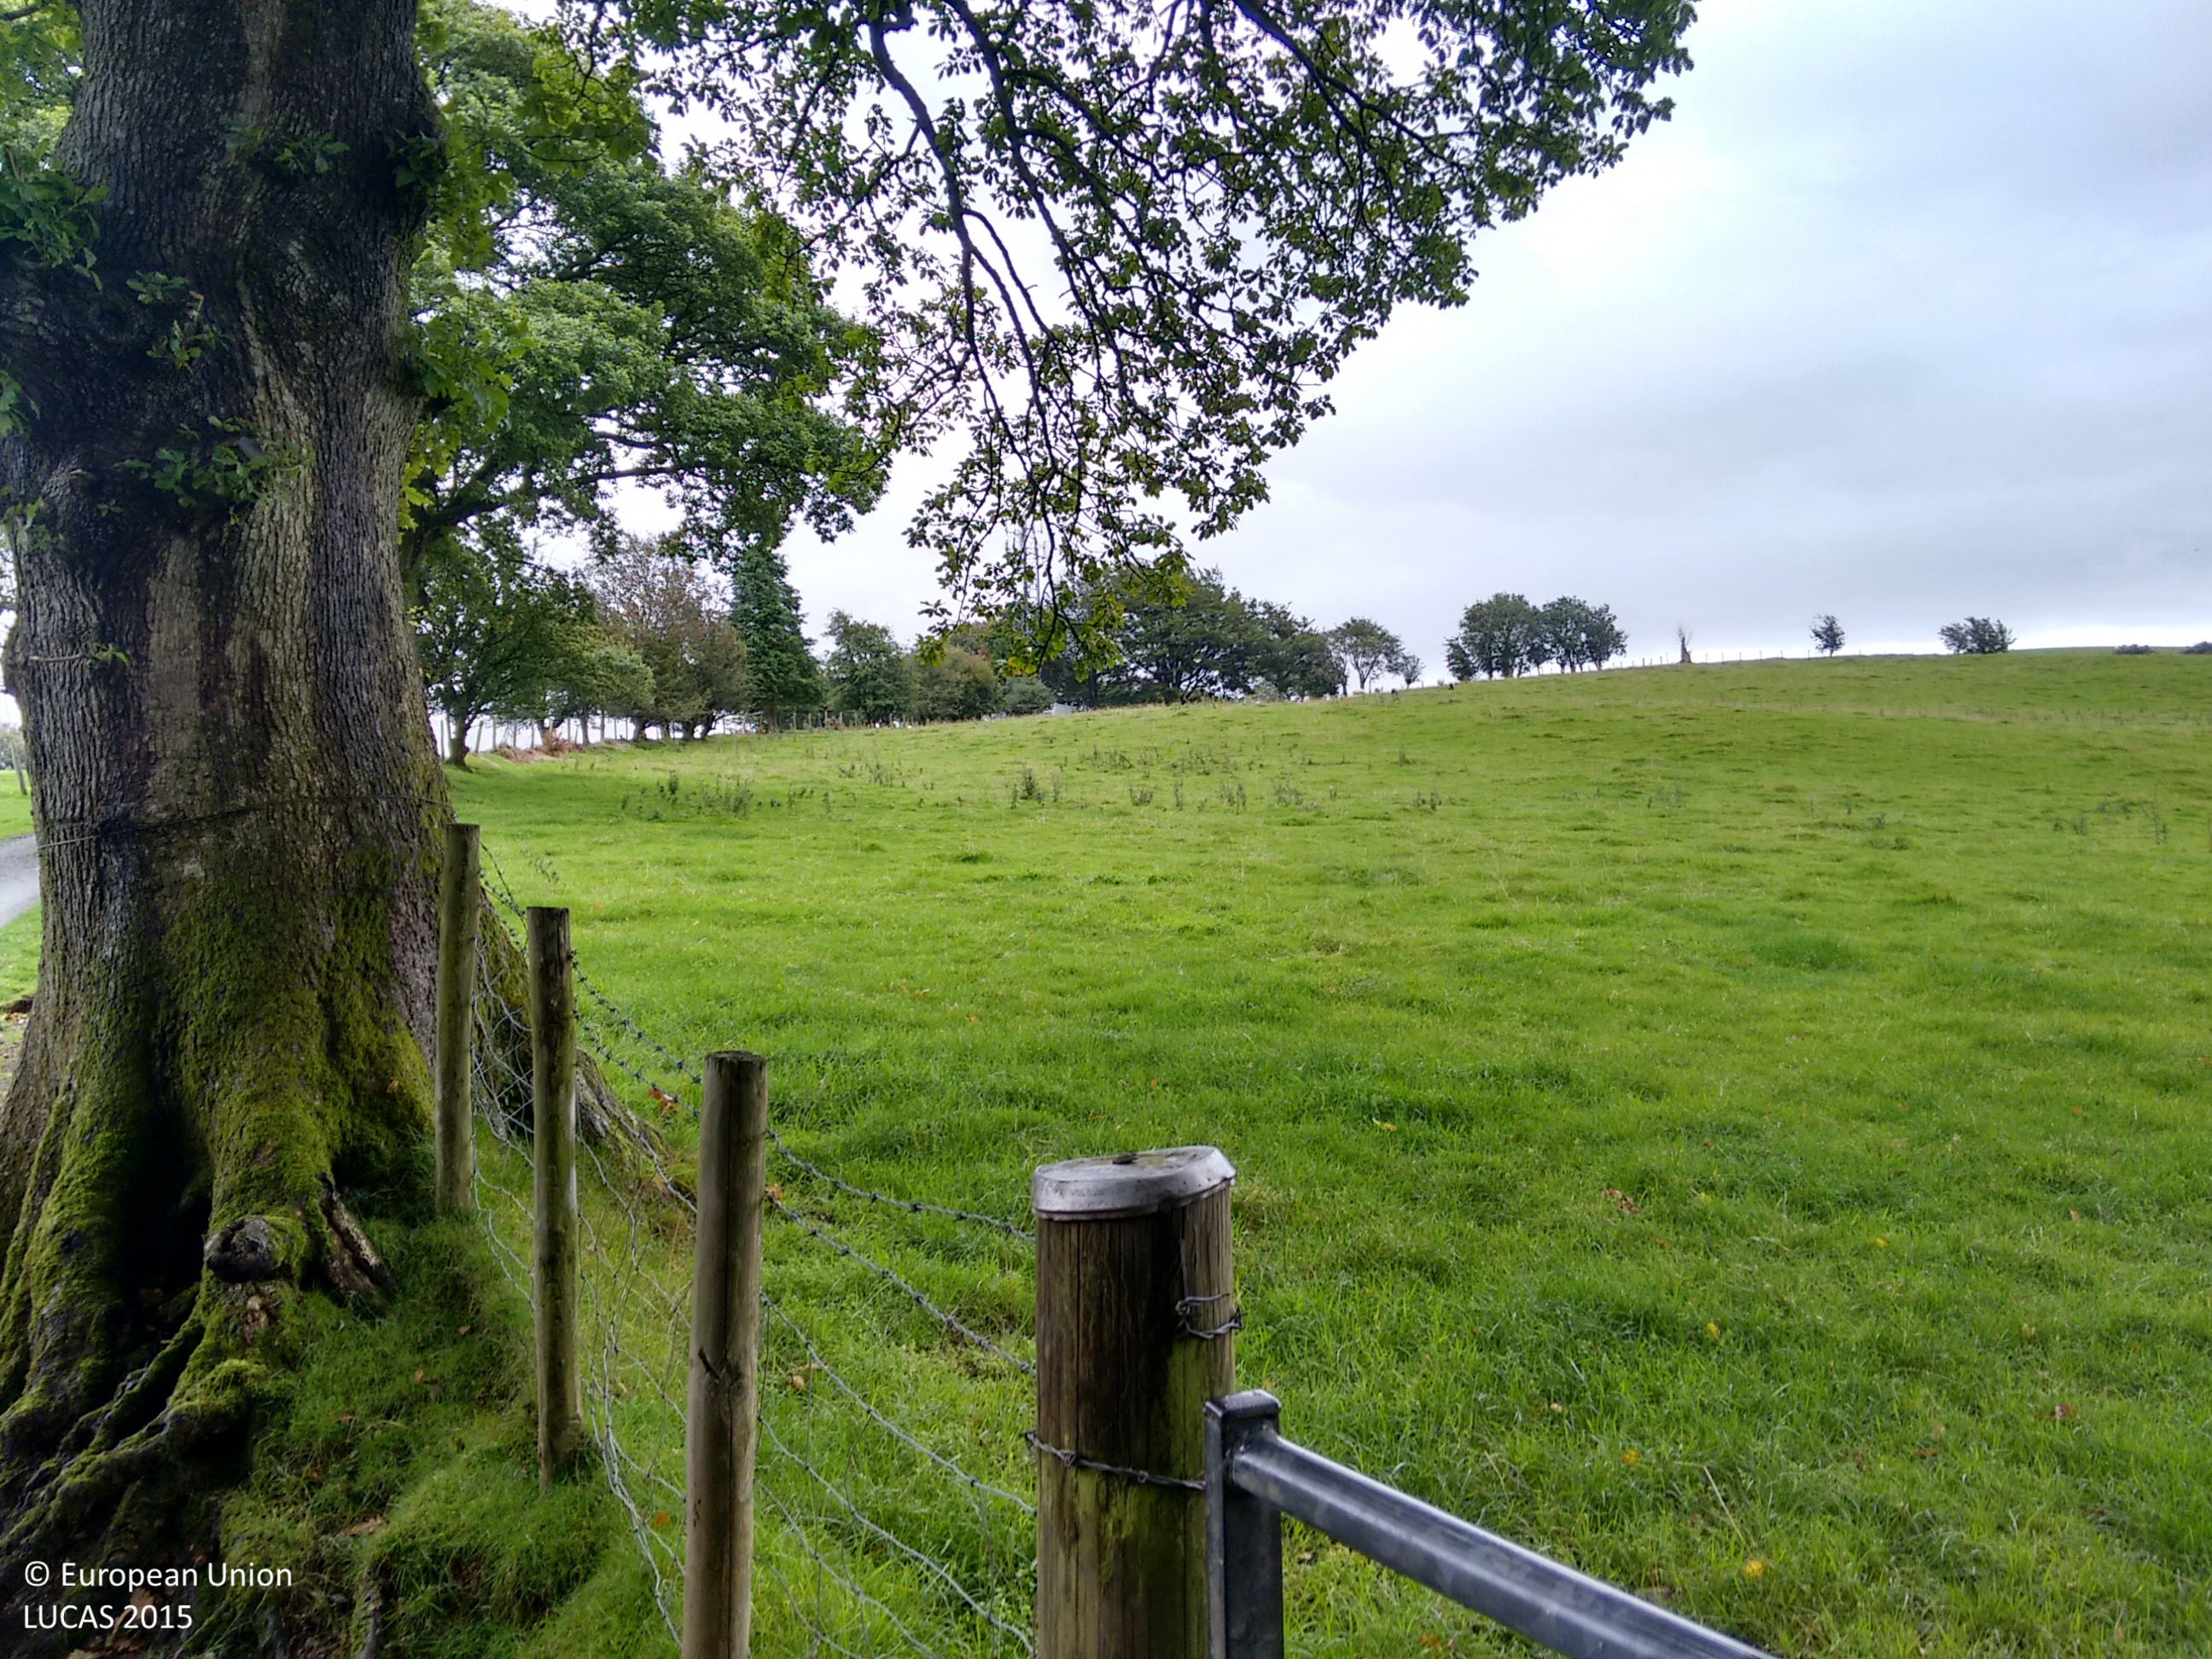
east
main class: Woodland
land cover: Broadleaved woodland
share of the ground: > 75 %
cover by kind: broadleaved forest trees 60 %, herbaceous plants 40 %
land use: Agriculture (excluding fallow land and kitchen gardens)
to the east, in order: Broadleaved woodland; Grassland without tree/shrub cover; Tracks; Grassland without tree/shrub cover; Fences; Grassland without tree/shrub cover
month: September
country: GB
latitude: 52.2265
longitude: -3.9278
